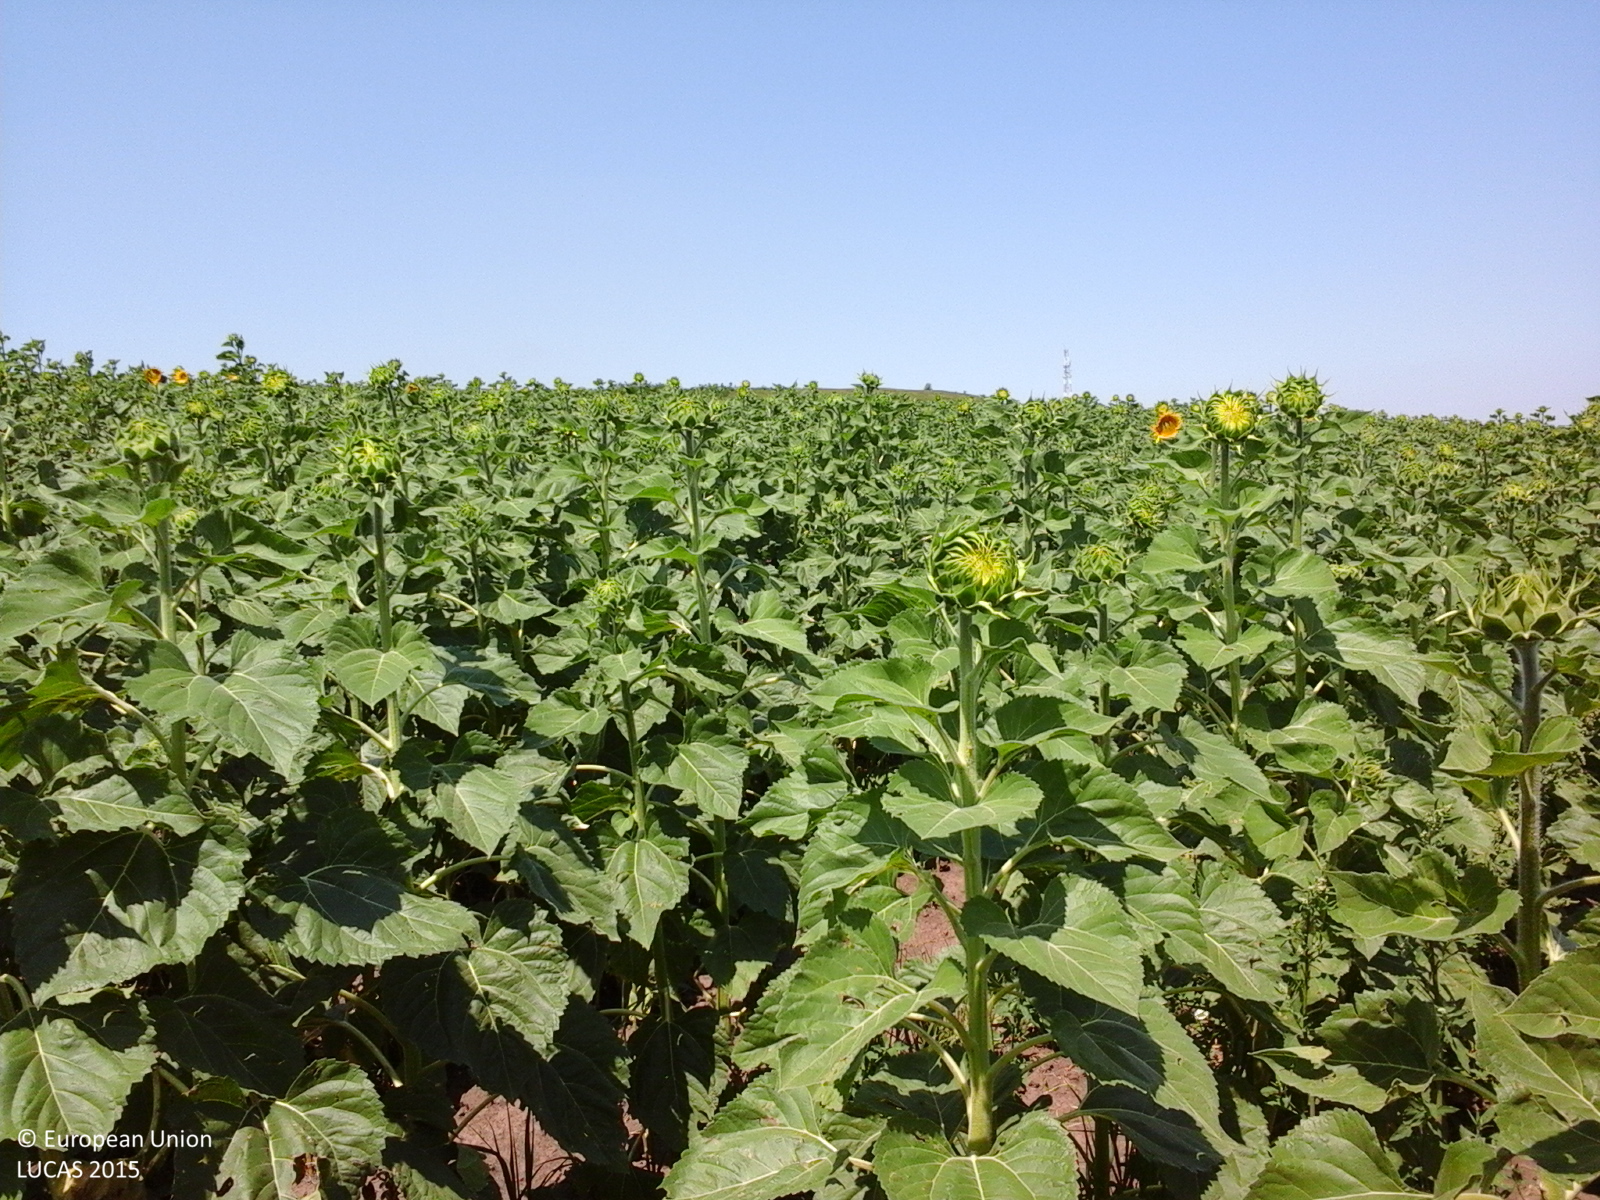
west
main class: Cropland
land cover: Sunflower
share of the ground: > 75 %
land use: Agriculture (excluding fallow land and kitchen gardens)
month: June
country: RO
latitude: 46.9403
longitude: 28.0363
